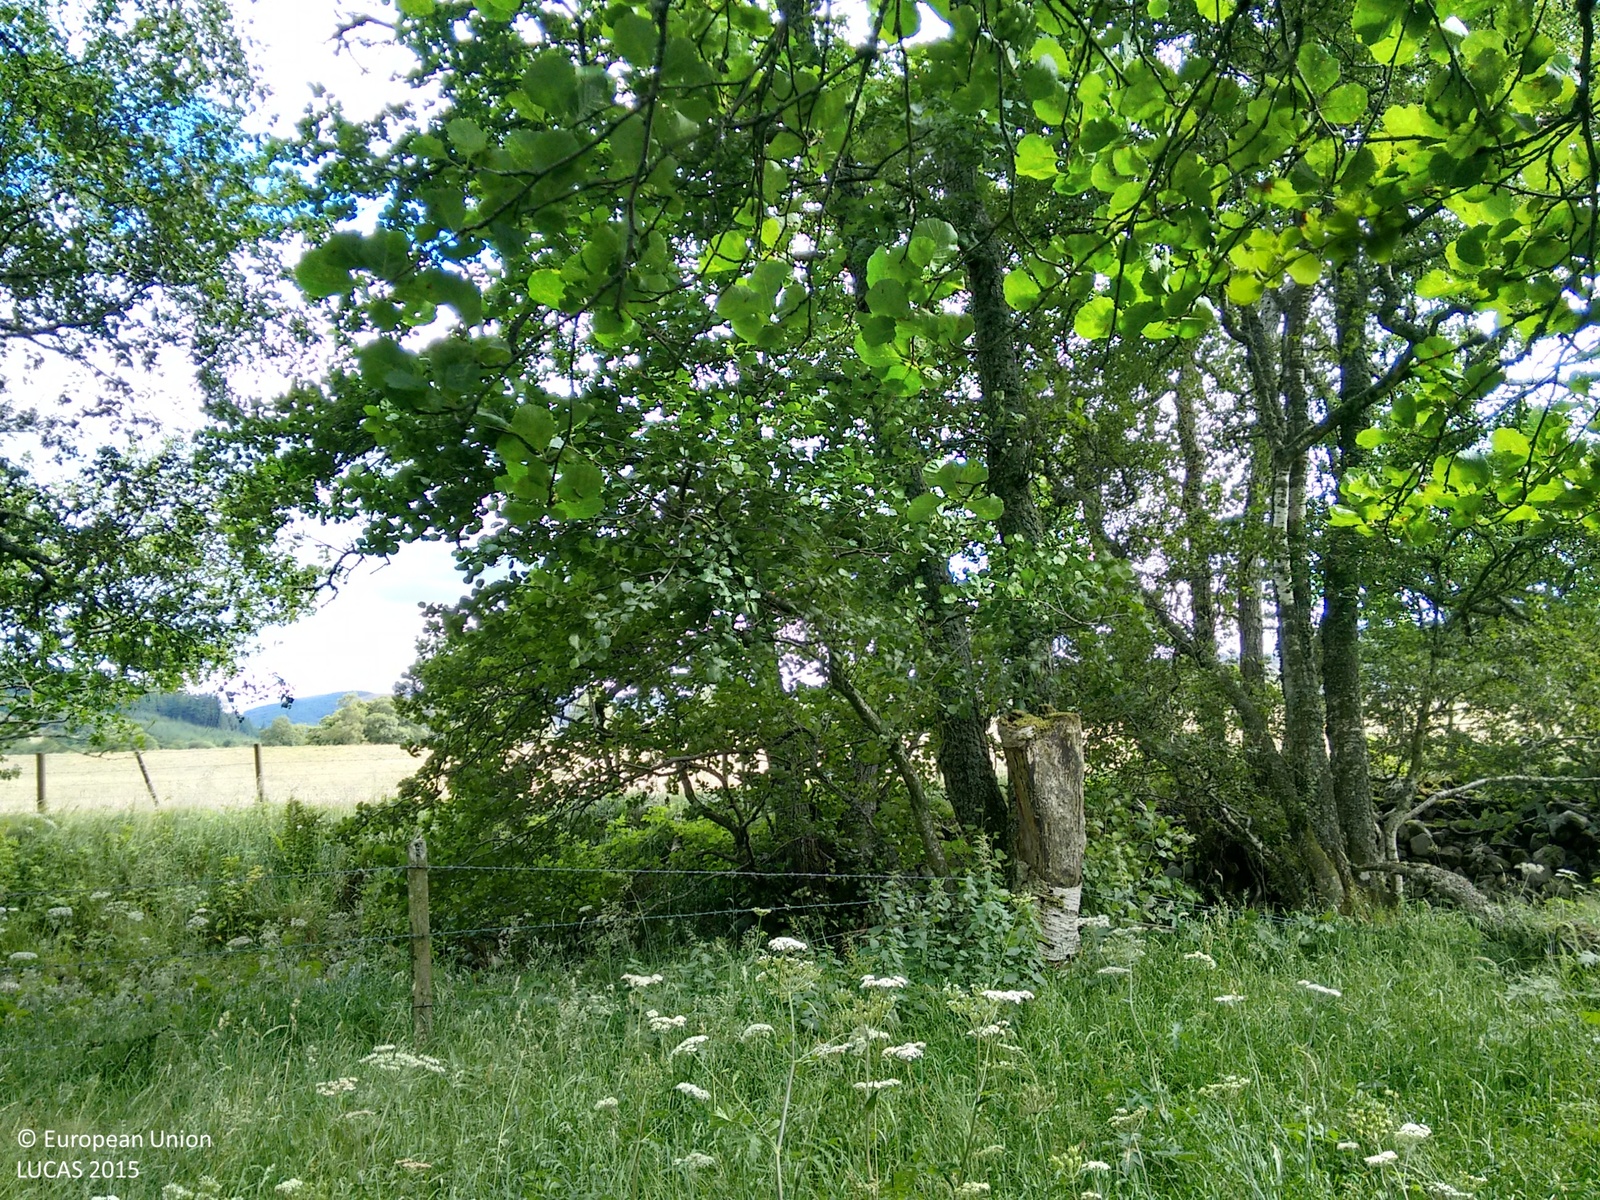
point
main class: Woodland
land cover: Broadleaved woodland
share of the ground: > 75 %
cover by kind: broadleaved forest trees 100 %
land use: Agriculture (excluding fallow land and kitchen gardens)
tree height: > 5 m
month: August
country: GB
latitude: 57.4105
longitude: -4.1502
